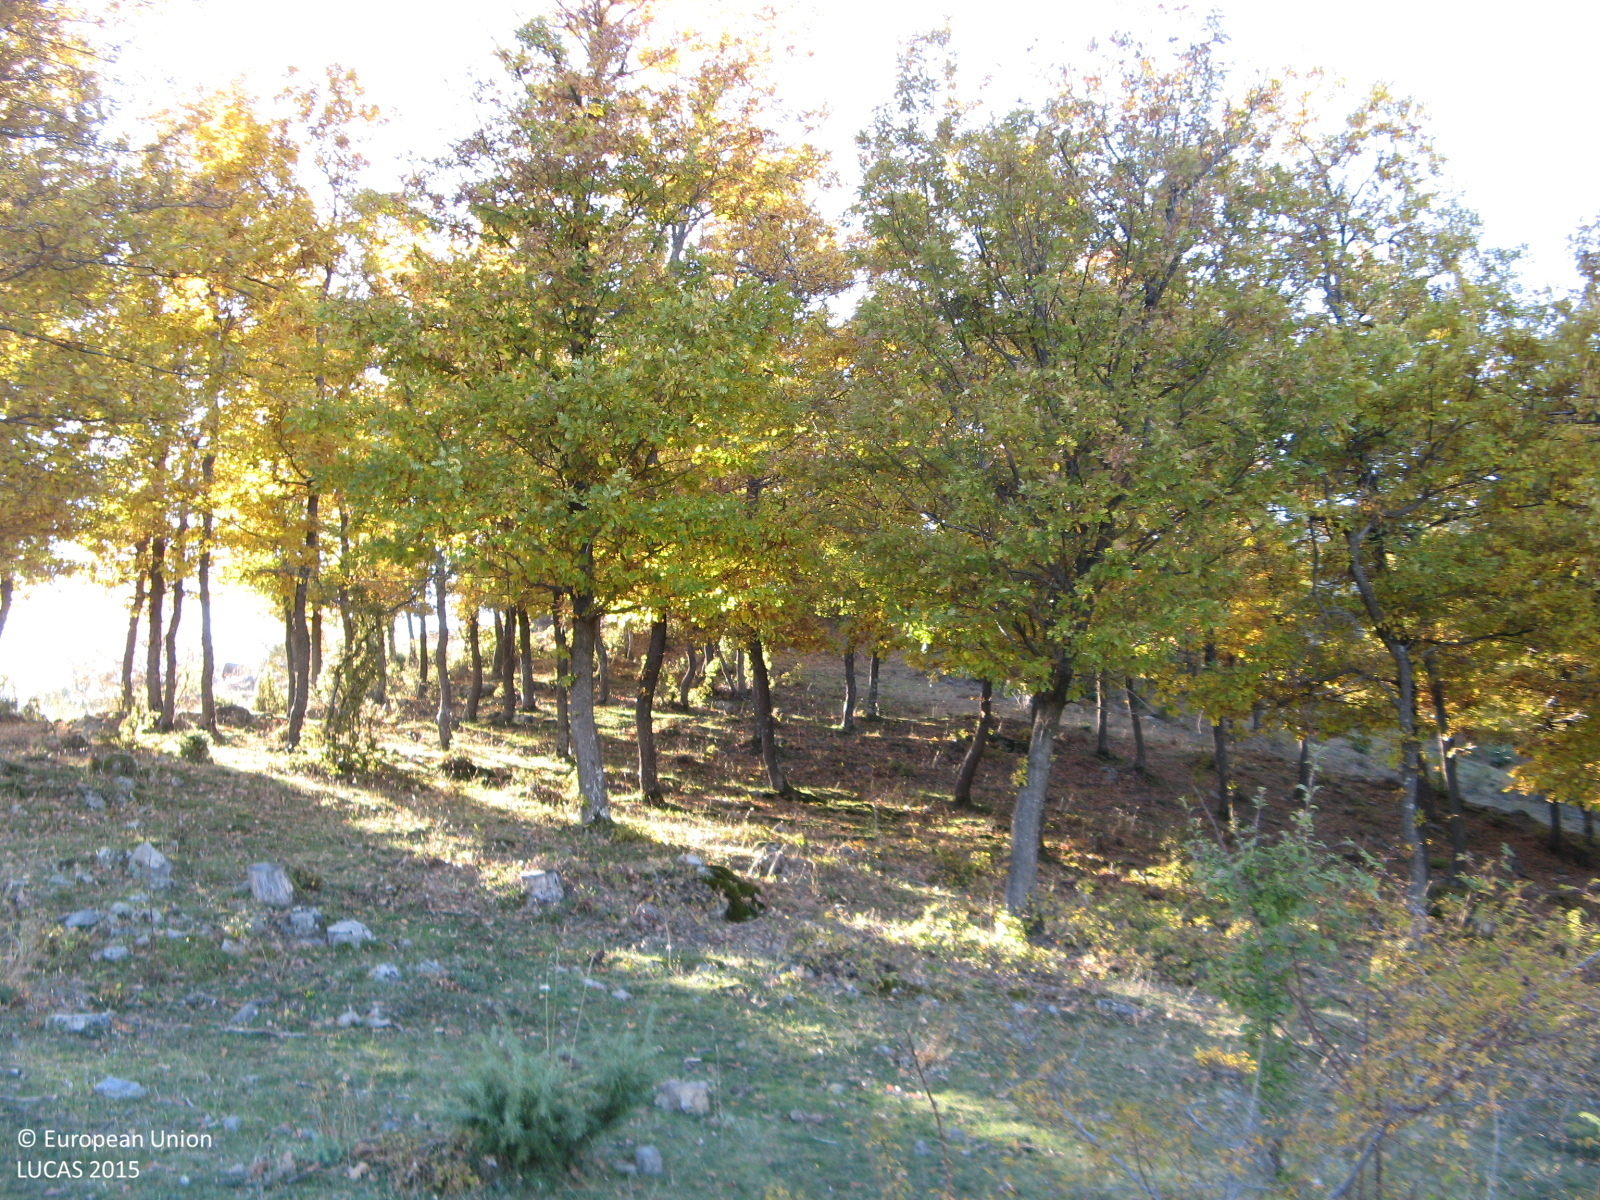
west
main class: Woodland
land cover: Pine dominated mixed woodland
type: hemiboreal forest and nemoral coniferous forest and mixed broadleaved-coniferous forest
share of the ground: > 75 %
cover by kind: coniferous forest trees 75 %, broadleaved forest trees 25 %
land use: Semi-natural and natural areas not in use
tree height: > 5 m
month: November
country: BG
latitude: 41.7107
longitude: 25.1365
